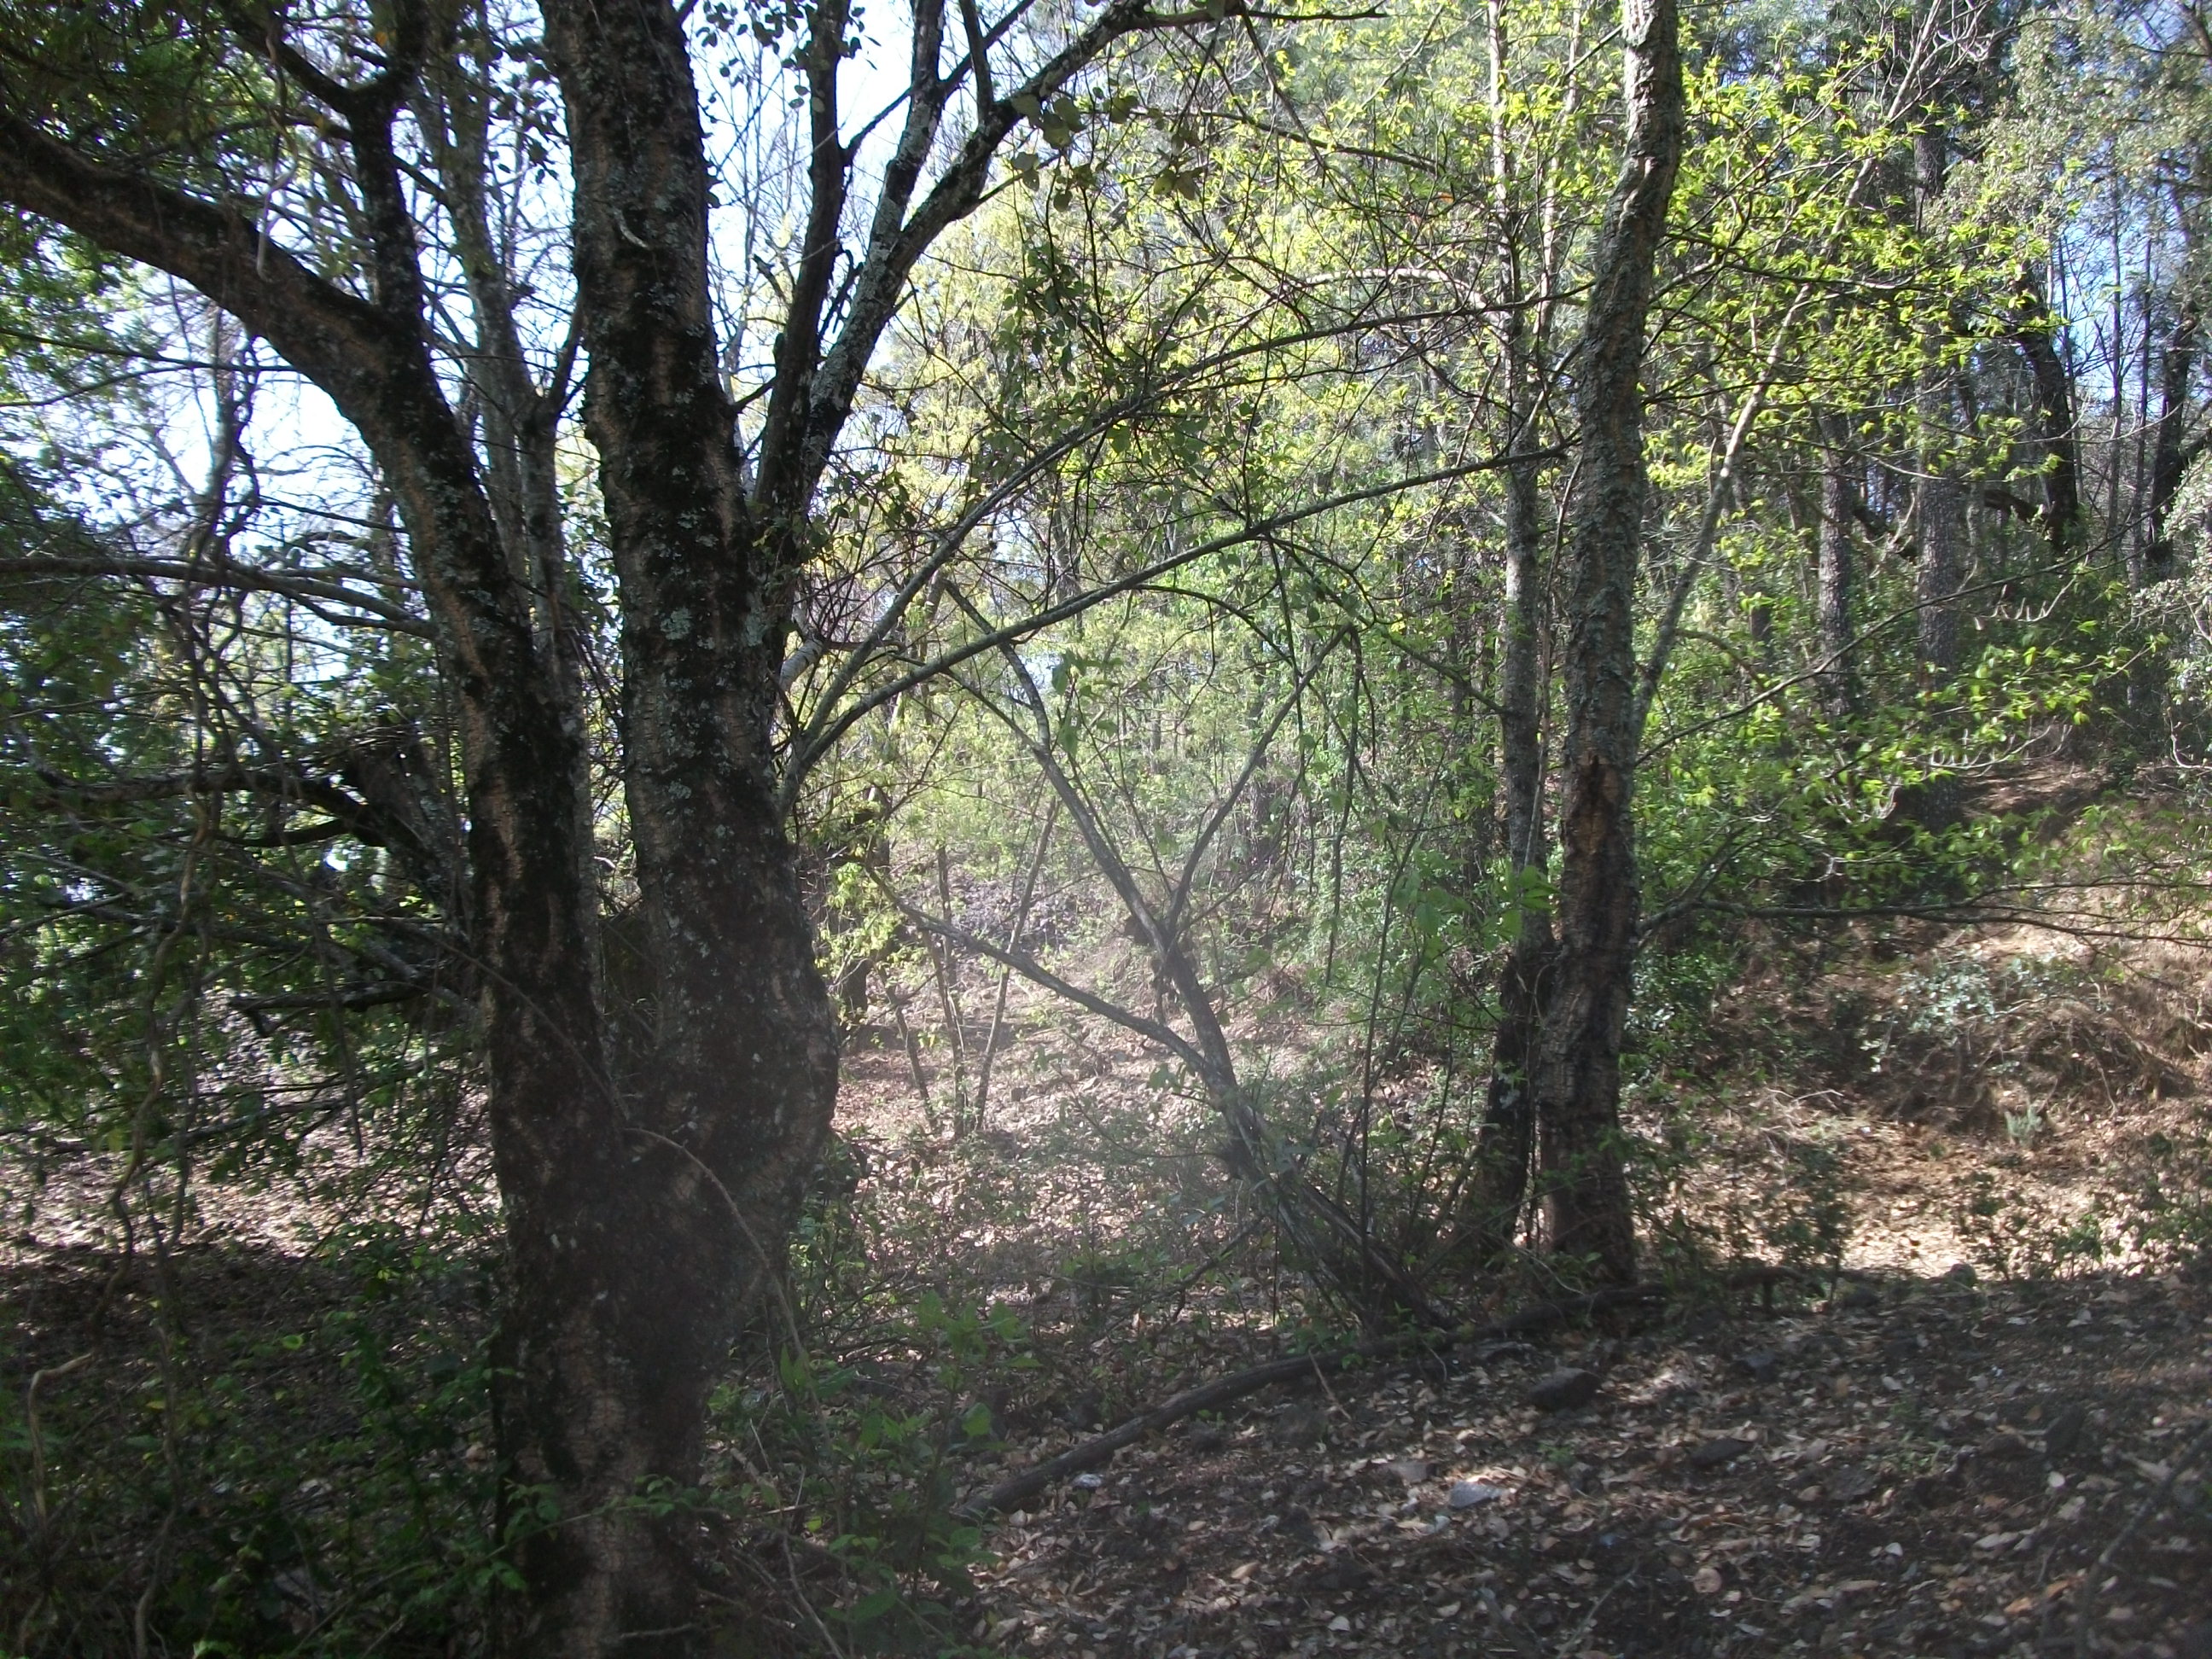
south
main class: Woodland
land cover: Broadleaved woodland
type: broadleaved evergreen forest
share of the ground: > 75 %
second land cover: Spontaneously vegetated surfaces
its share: < 10 %
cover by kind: broadleaved forest trees 95 %, herbaceous plants 5 %
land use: Forestry
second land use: Agriculture (excluding fallow land and kitchen gardens)
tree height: > 5 m
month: April
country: ES
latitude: 37.9149
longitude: -6.7339
